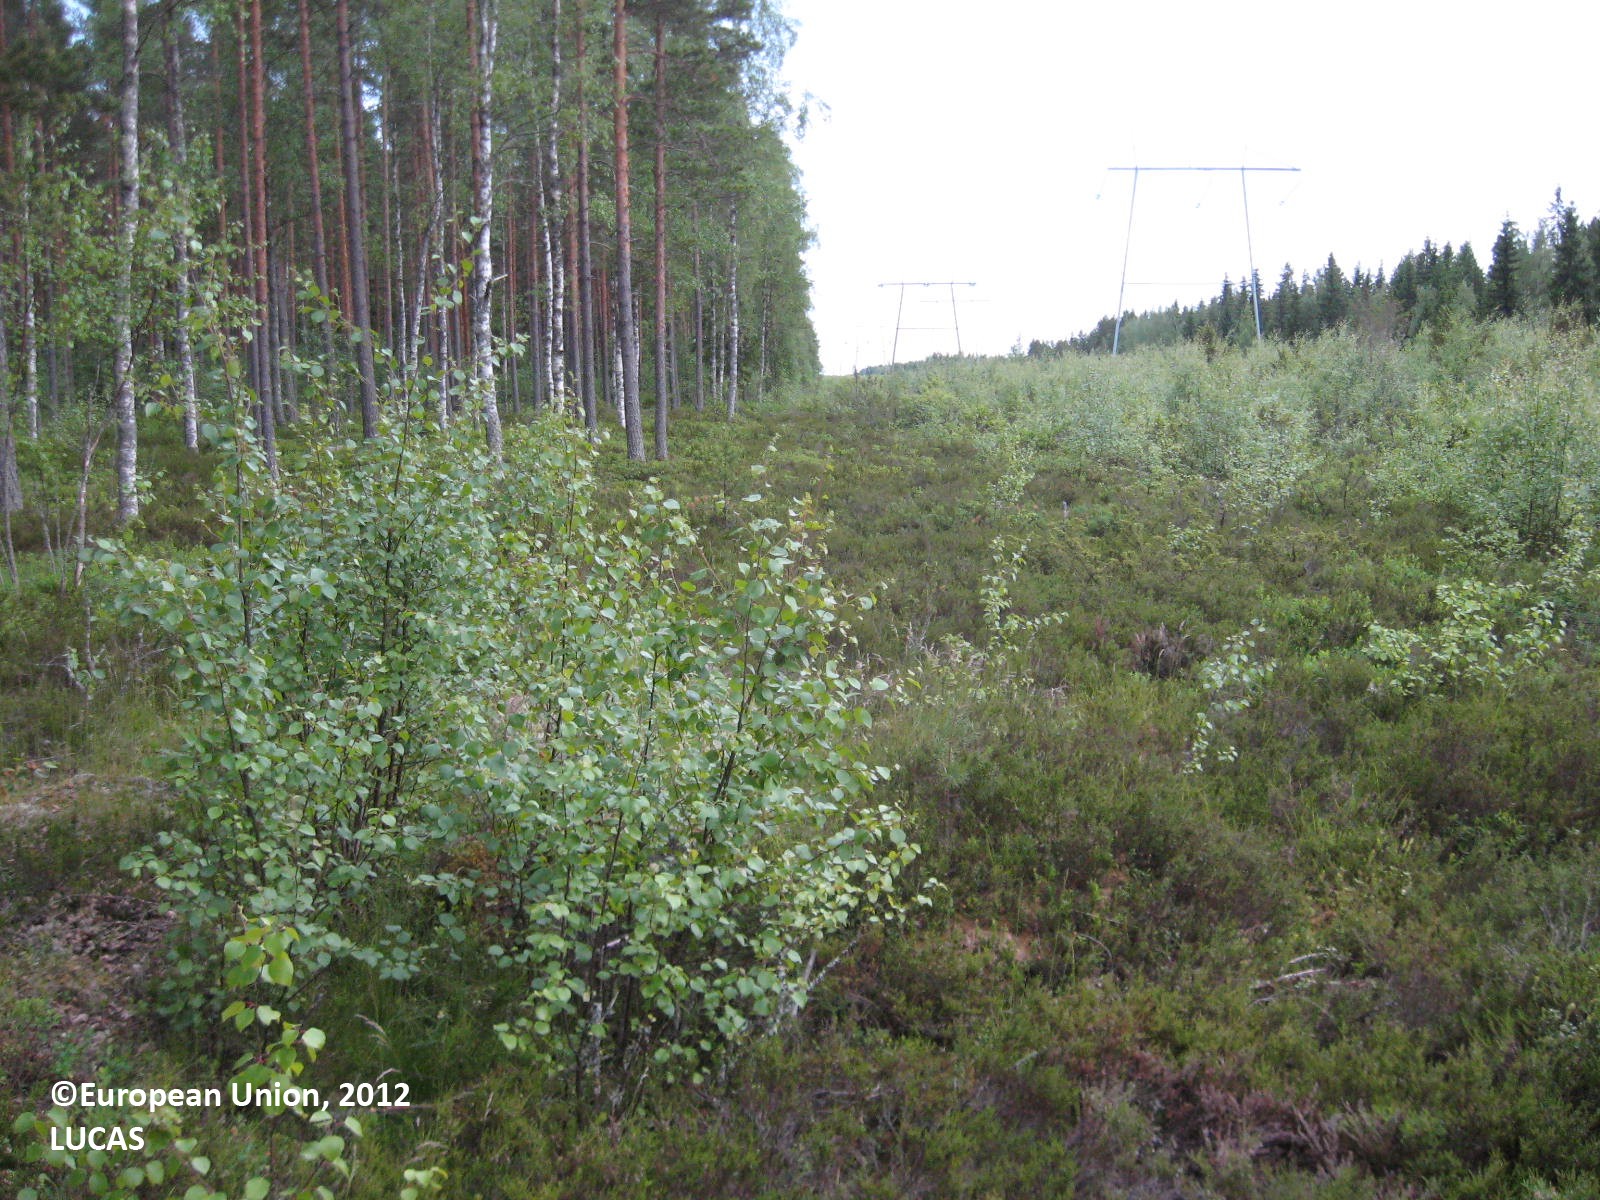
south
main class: Shrubland
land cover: Shrubland without tree cover
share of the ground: > 75 %
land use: Energy production
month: June
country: FI
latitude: 62.7371
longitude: 21.7262
